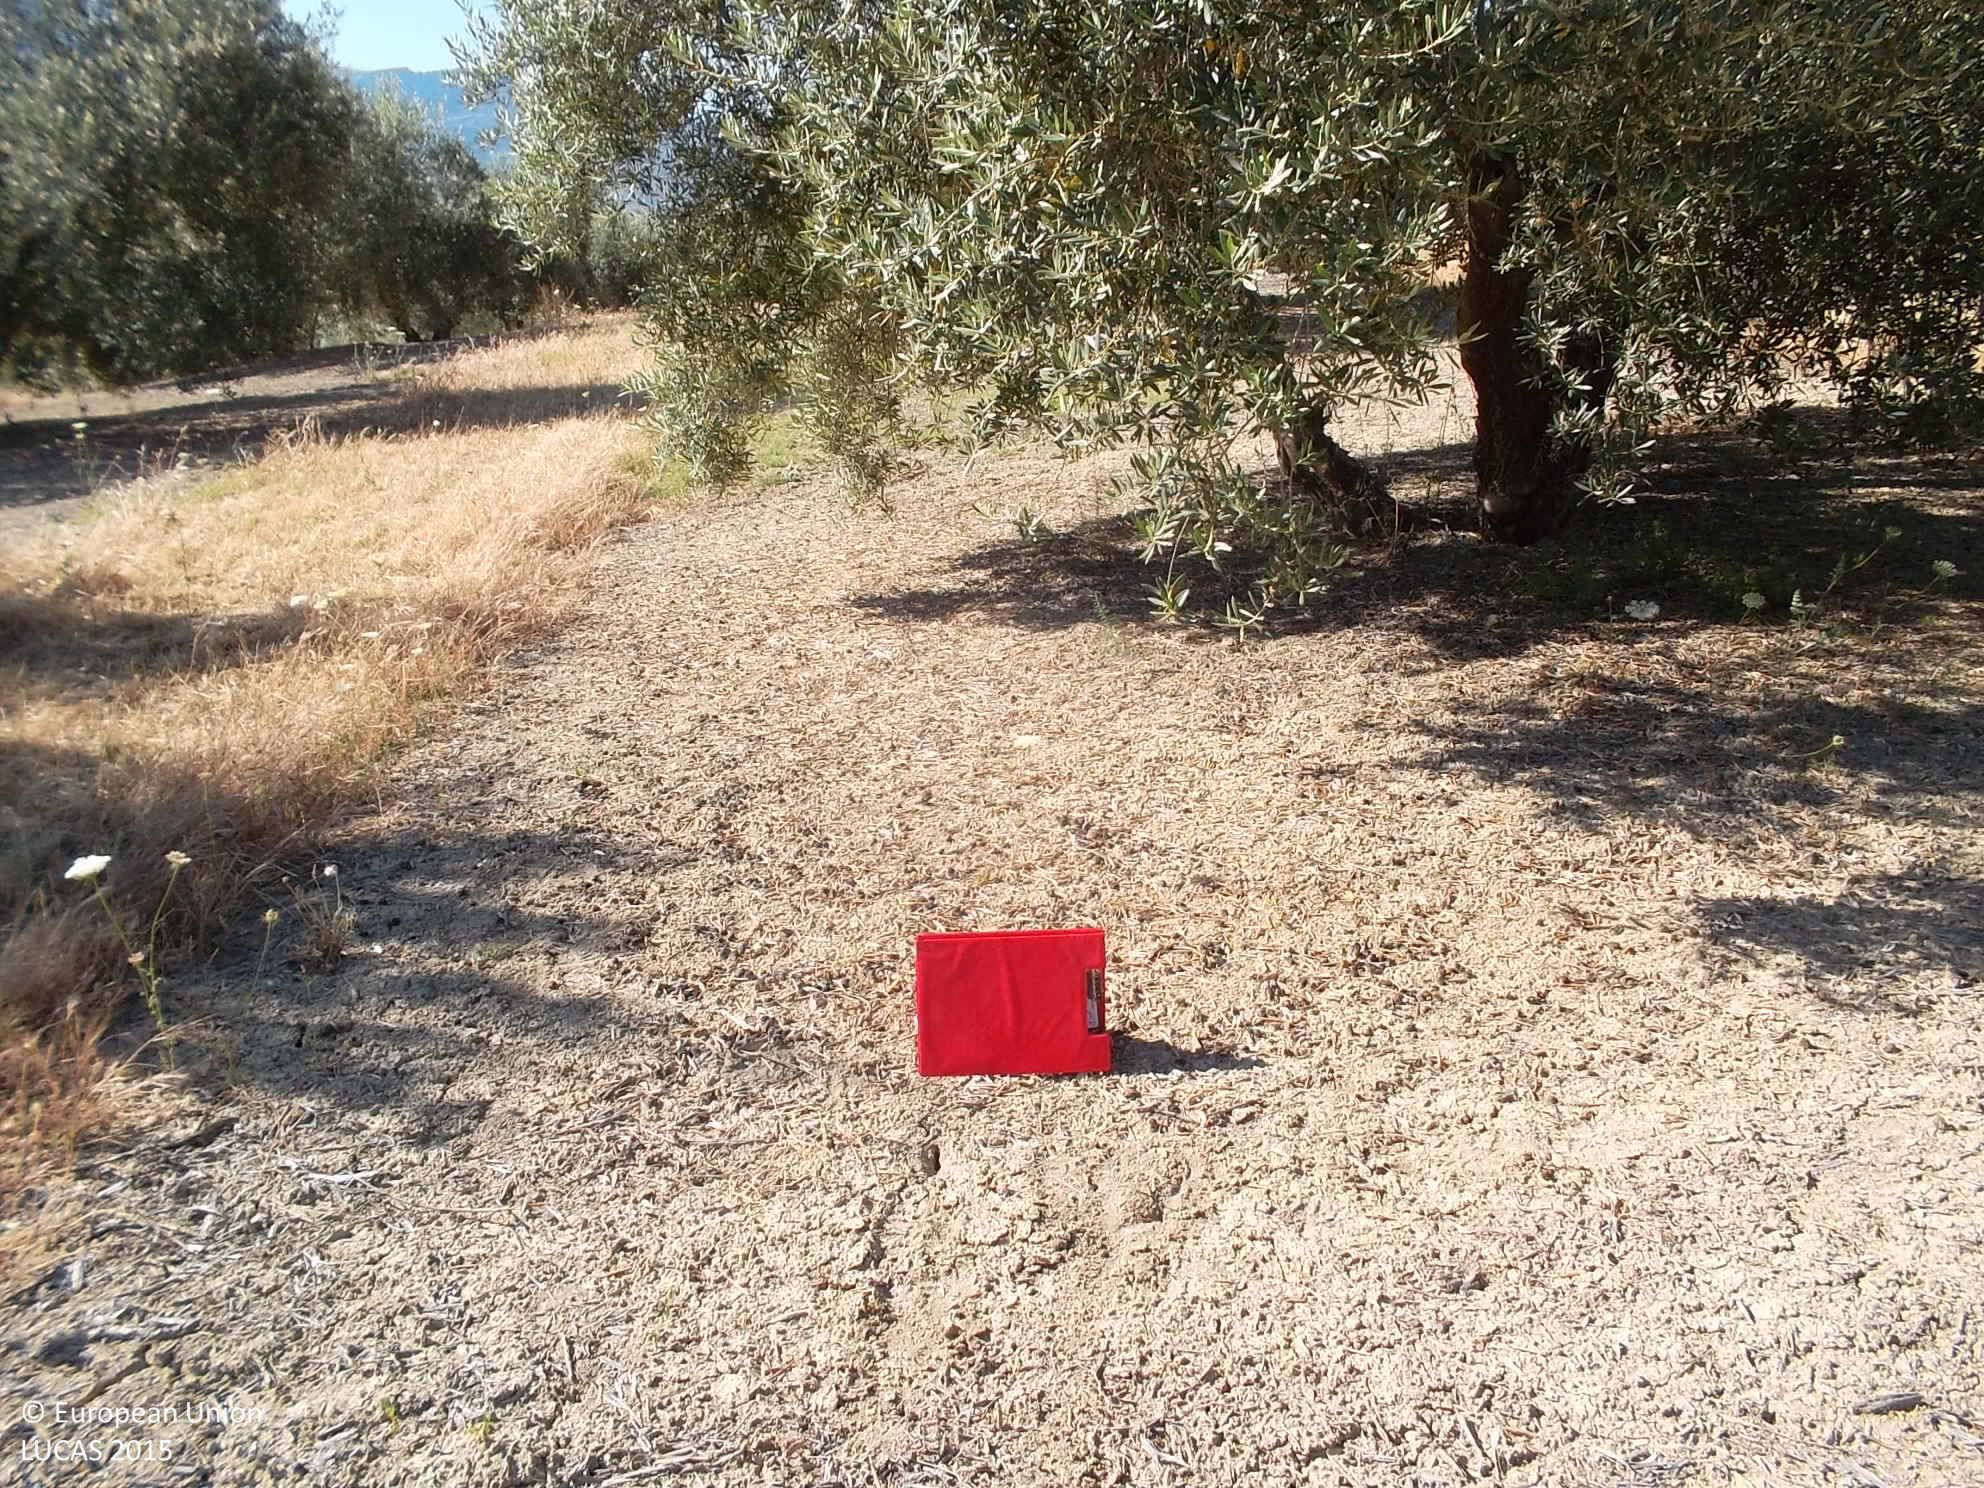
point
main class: Cropland
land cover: Olive groves
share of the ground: 50 - 75 %
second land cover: Other bare soil
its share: > 75 %
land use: Agriculture (excluding fallow land and kitchen gardens)
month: June
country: ES
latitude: 37.9774
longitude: -3.0775
